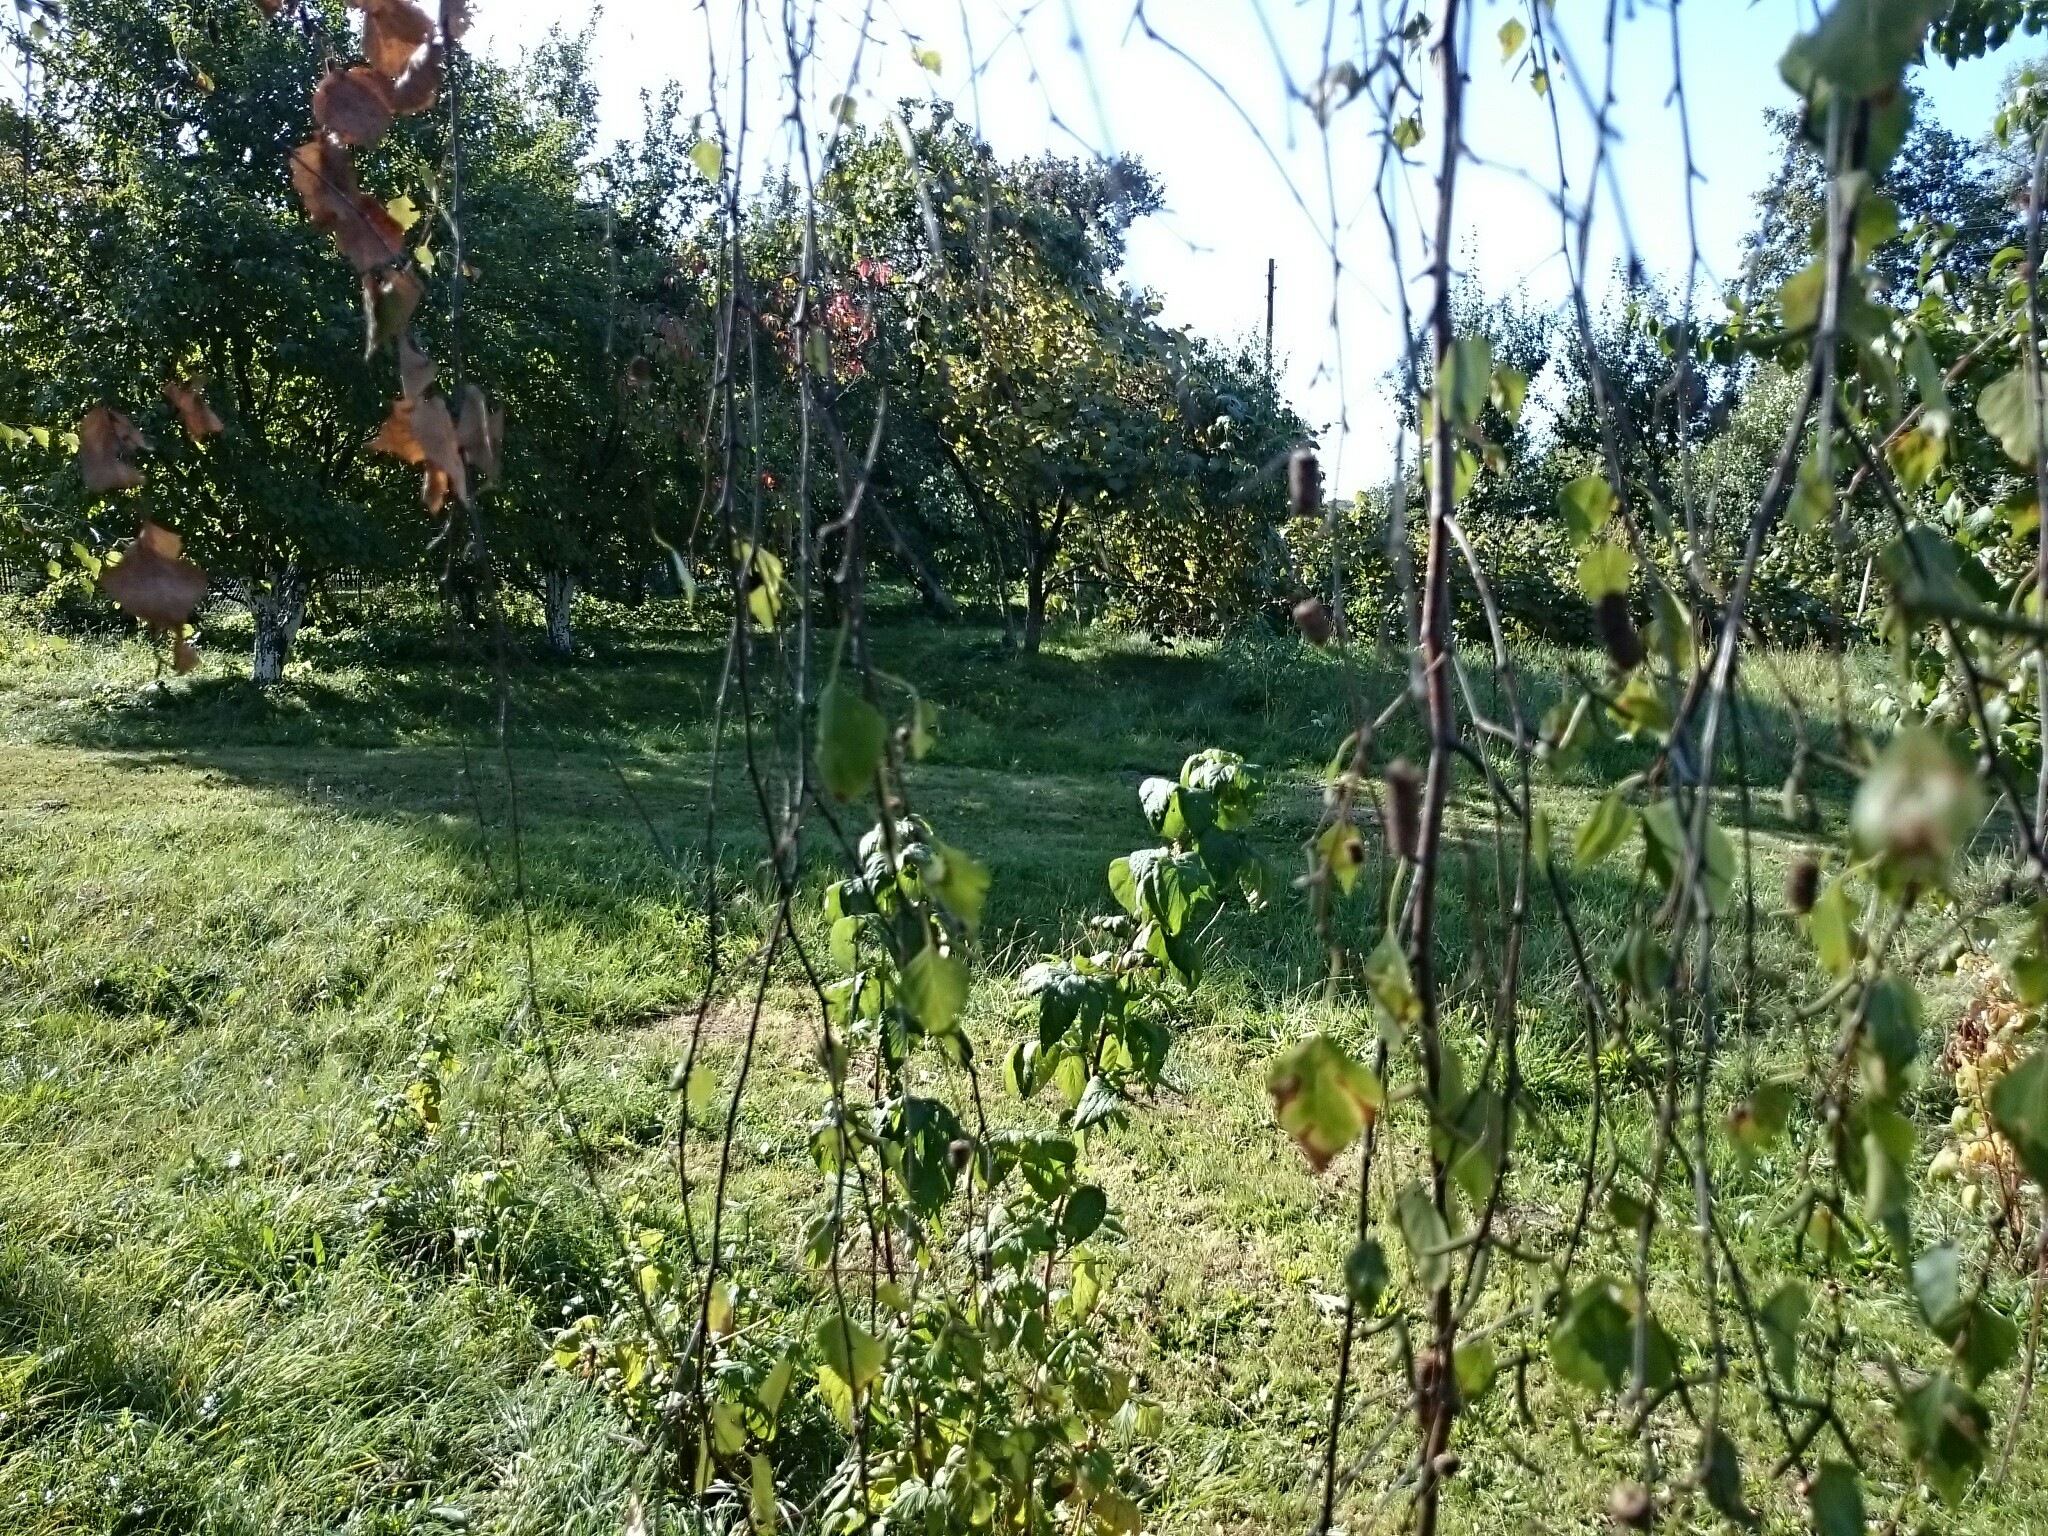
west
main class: Grassland
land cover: Grassland with sparse tree/shrub cover
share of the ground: > 75 %
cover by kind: herbaceous plants 90 %, broadleaved forest trees 5 %, shrubs 5 %
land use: Semi-natural and natural areas not in use
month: September
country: PL
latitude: 51.5000
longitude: 17.3443
